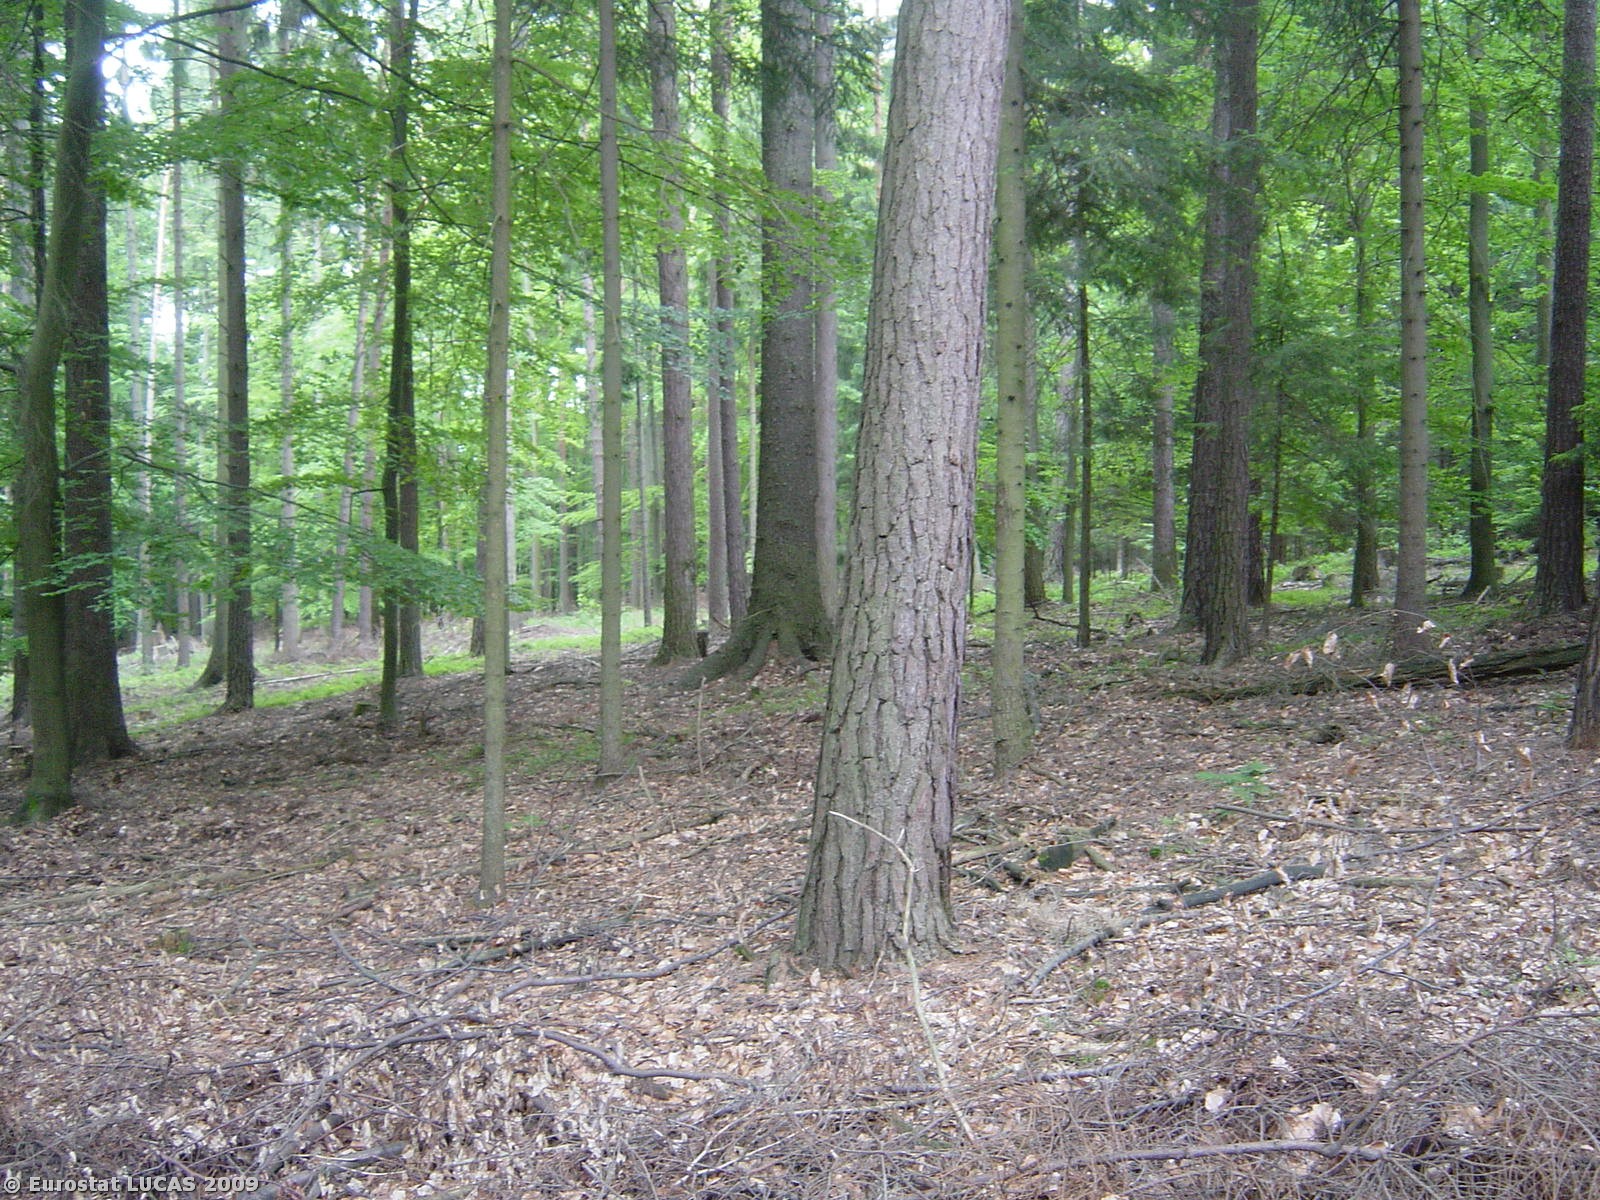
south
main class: Woodland
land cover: Mixed woodland
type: hemiboreal forest and nemoral coniferous forest and mixed broadleaved-coniferous forest
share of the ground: > 75 %
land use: Forestry
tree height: > 5 m
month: June
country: CZ
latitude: 49.8884
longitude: 16.5355
